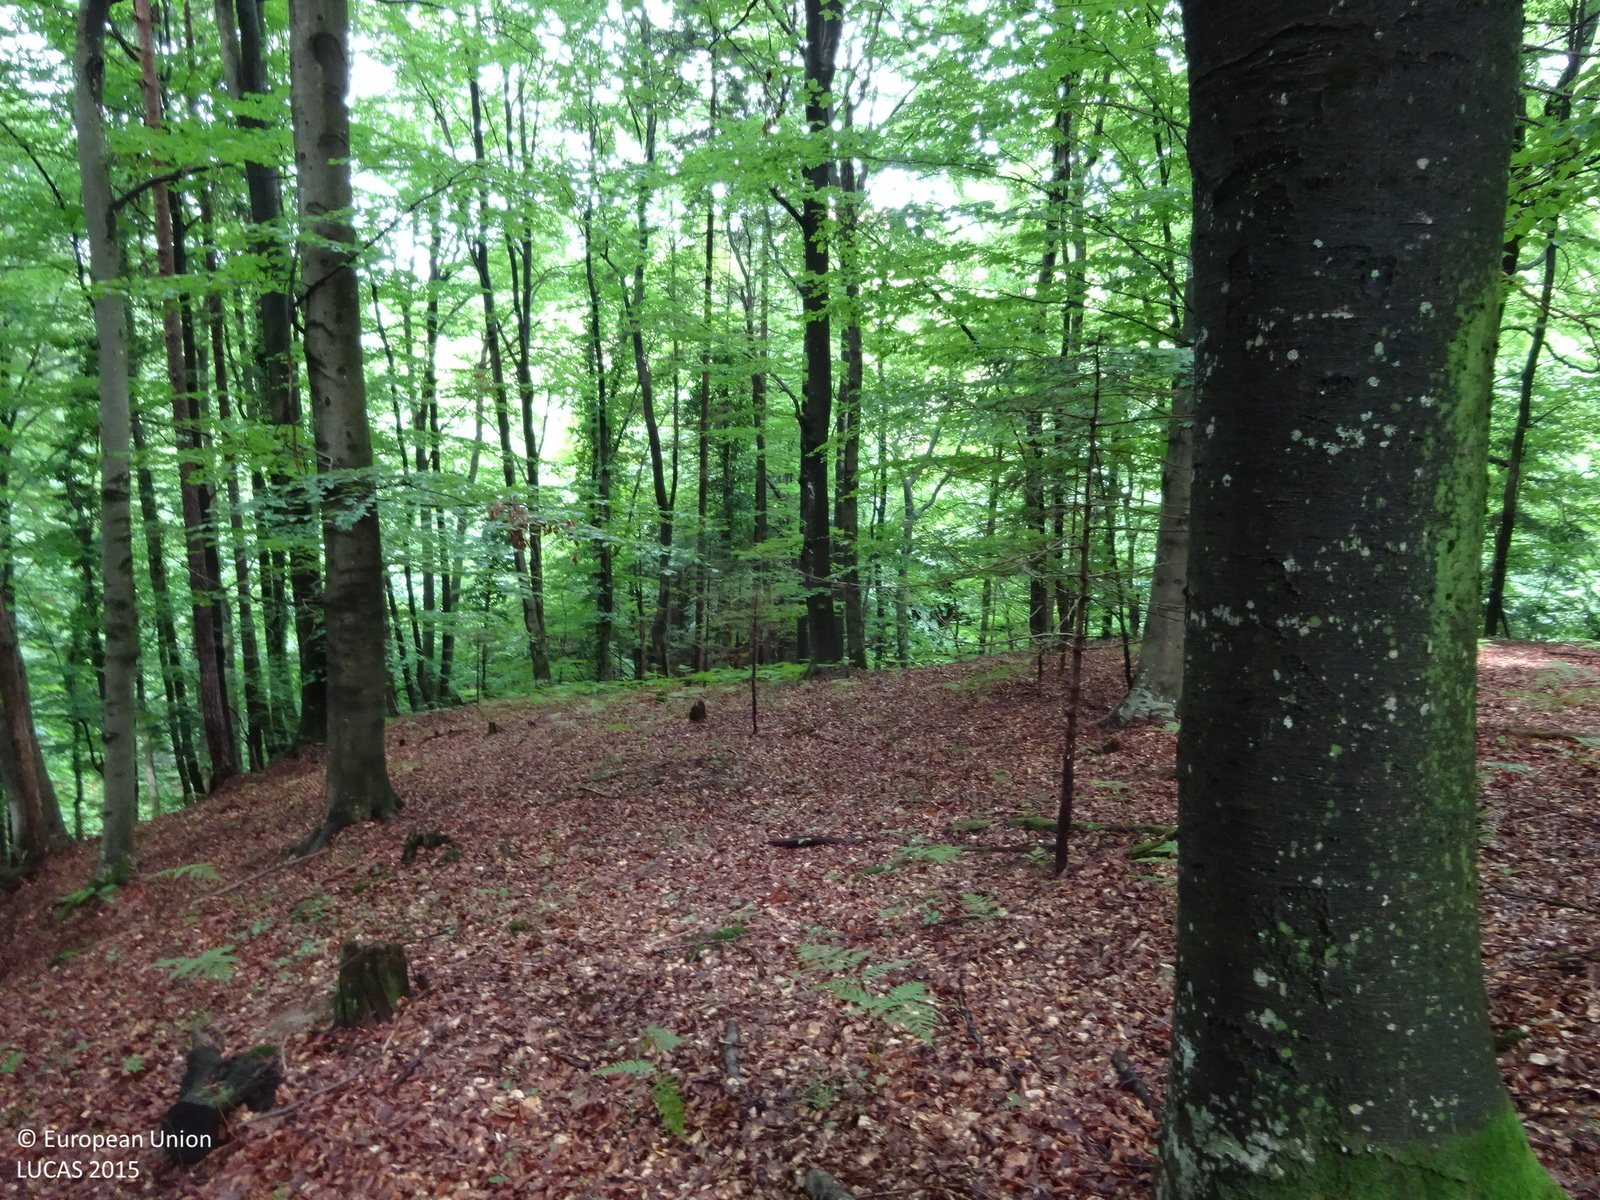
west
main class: Woodland
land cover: Broadleaved woodland
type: mountainous beech forest
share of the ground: > 75 %
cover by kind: broadleaved forest trees 90 %, unconsolidated bare surface 10 %
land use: Forestry
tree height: > 5 m
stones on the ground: < 10 %
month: June
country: AT
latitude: 46.7008
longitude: 15.4266
